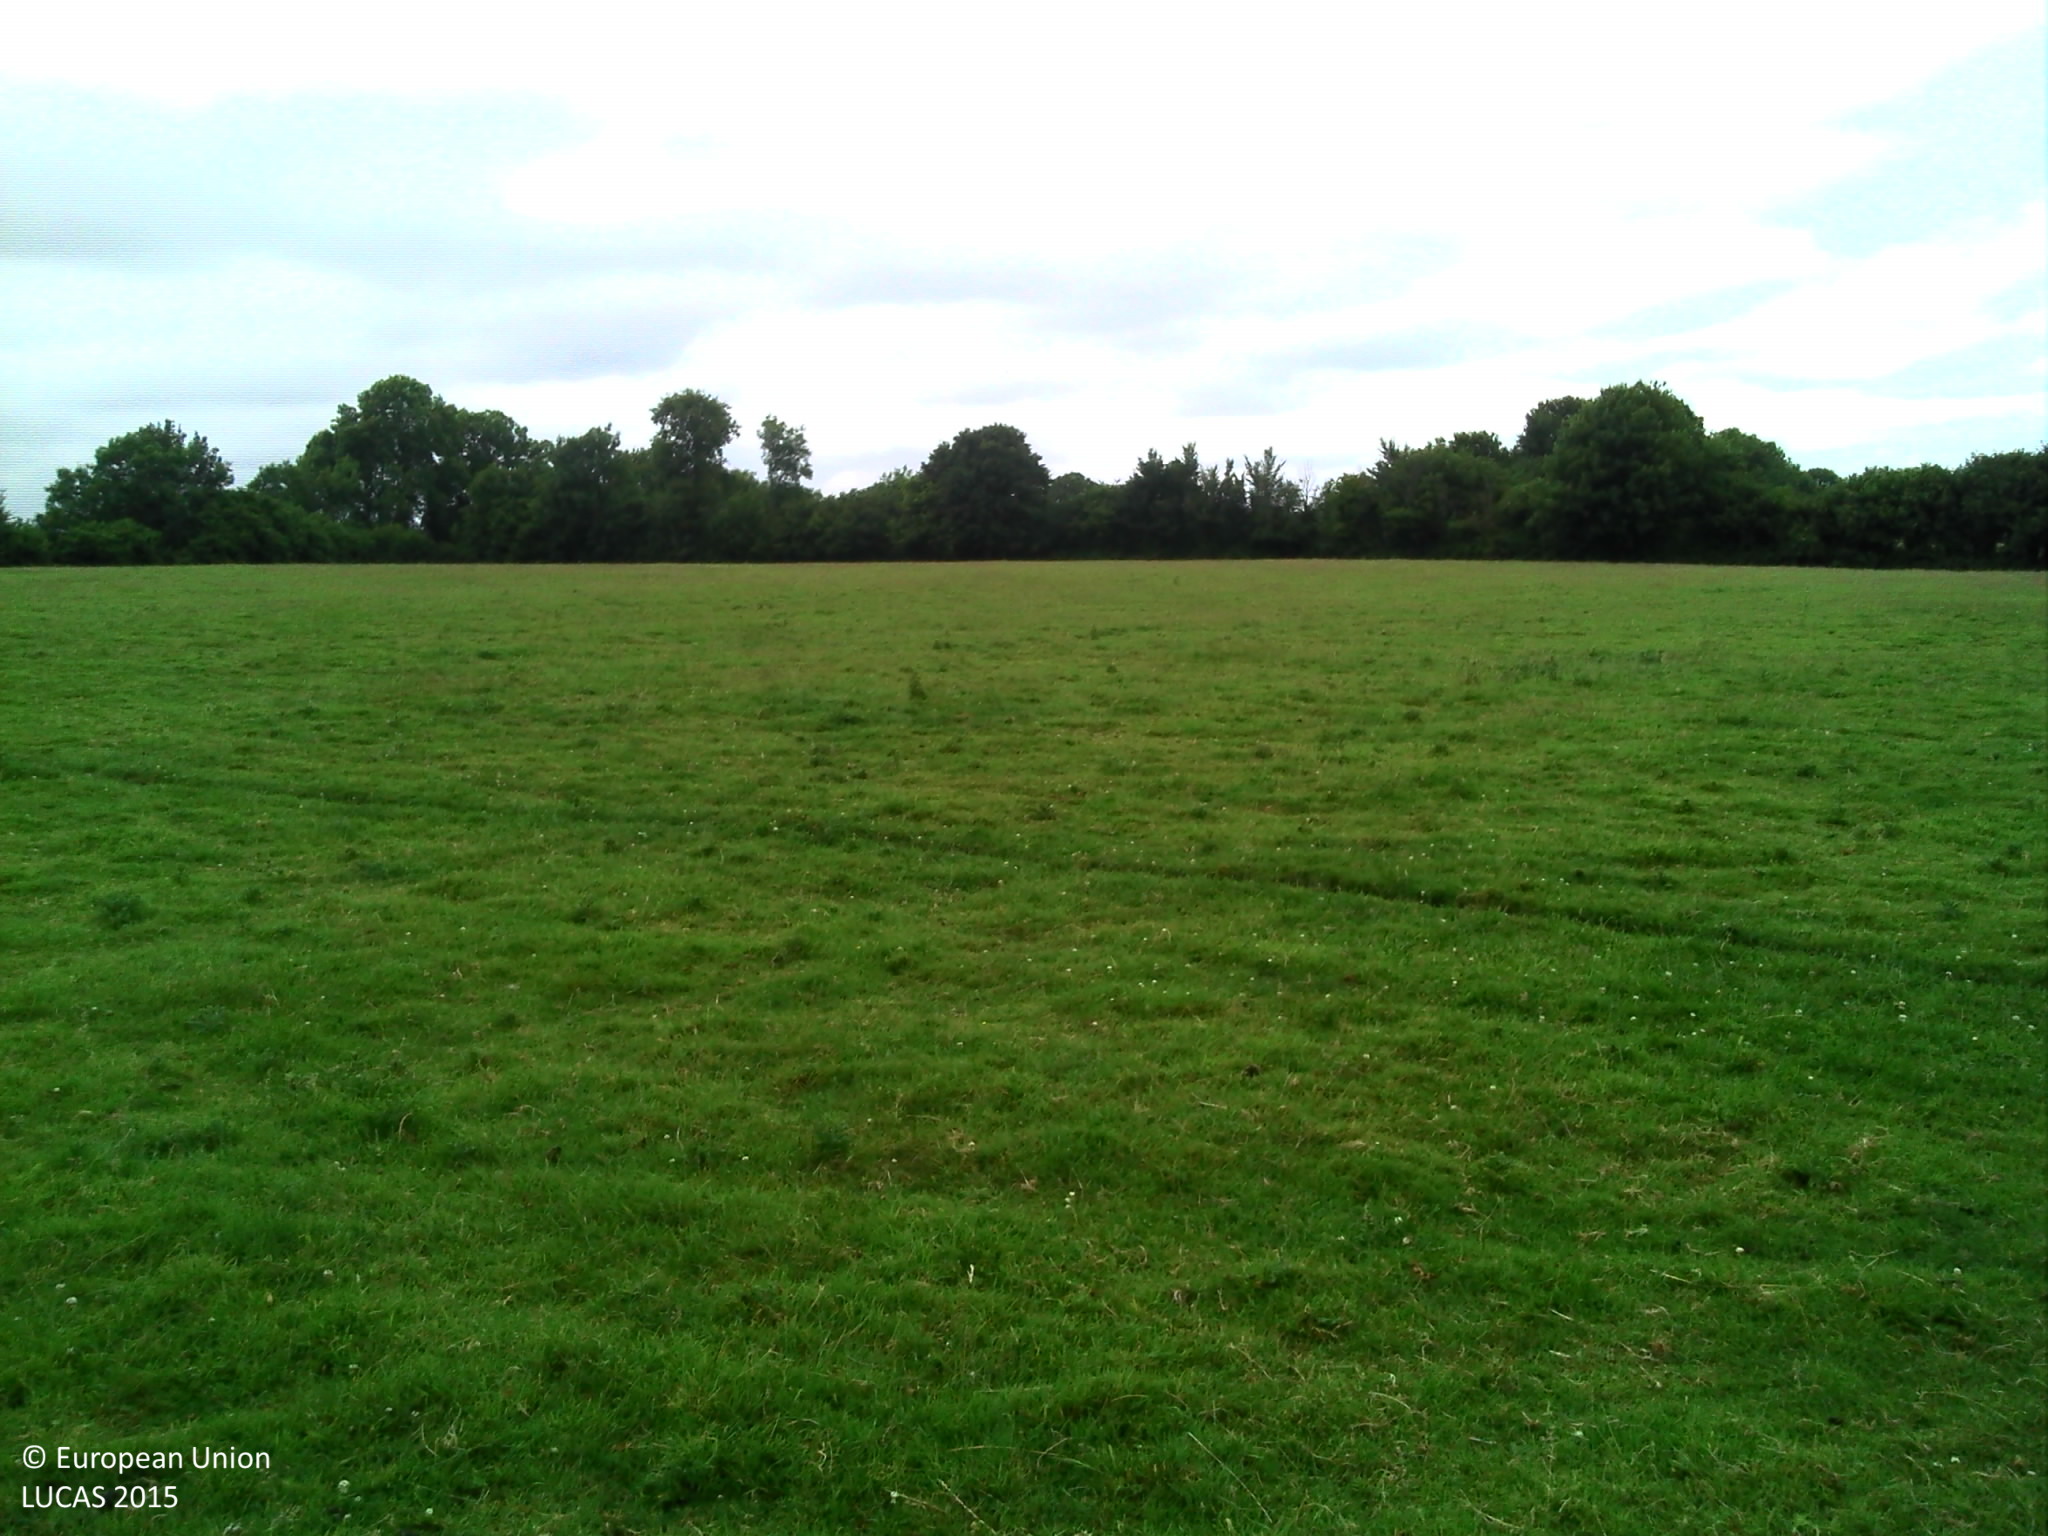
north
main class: Grassland
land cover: Grassland without tree/shrub cover
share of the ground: > 75 %
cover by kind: herbaceous plants 100 %
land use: Agriculture (excluding fallow land and kitchen gardens)
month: July
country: FR
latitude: 49.1043
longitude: -1.3748
